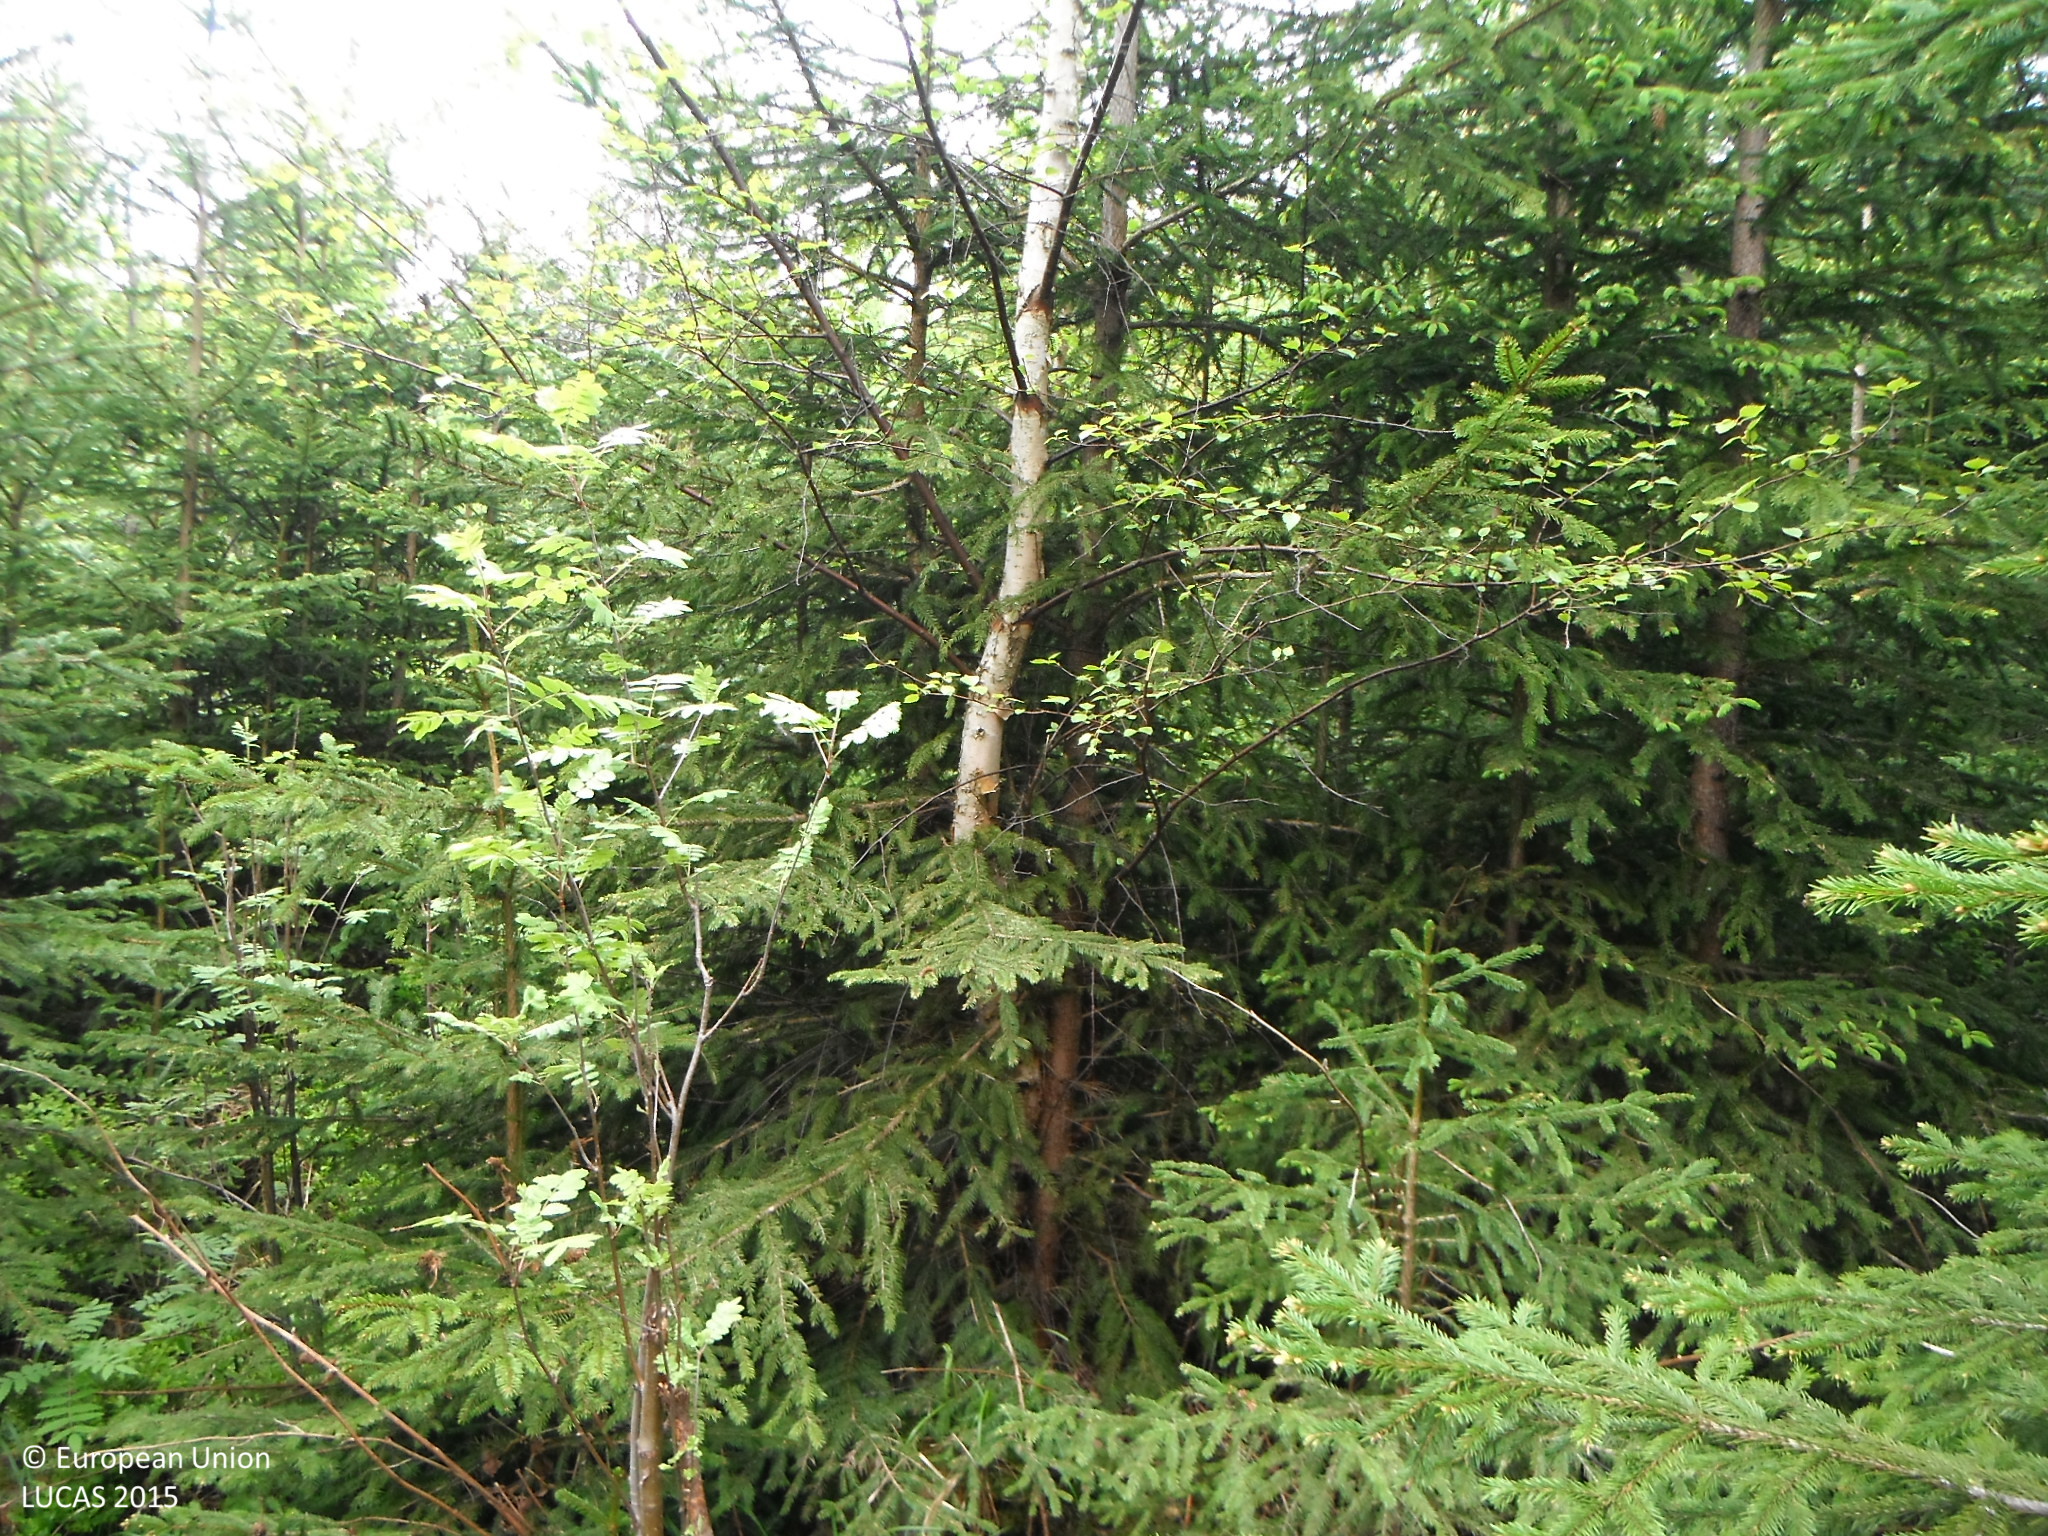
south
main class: Woodland
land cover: Spruce dominated mixed woodland
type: hemiboreal forest and nemoral coniferous forest and mixed broadleaved-coniferous forest
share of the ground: > 75 %
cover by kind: coniferous forest trees 65 %, broadleaved forest trees 35 %
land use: Forestry
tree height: > 5 m
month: May
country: SK
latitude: 49.1413
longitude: 20.2458
